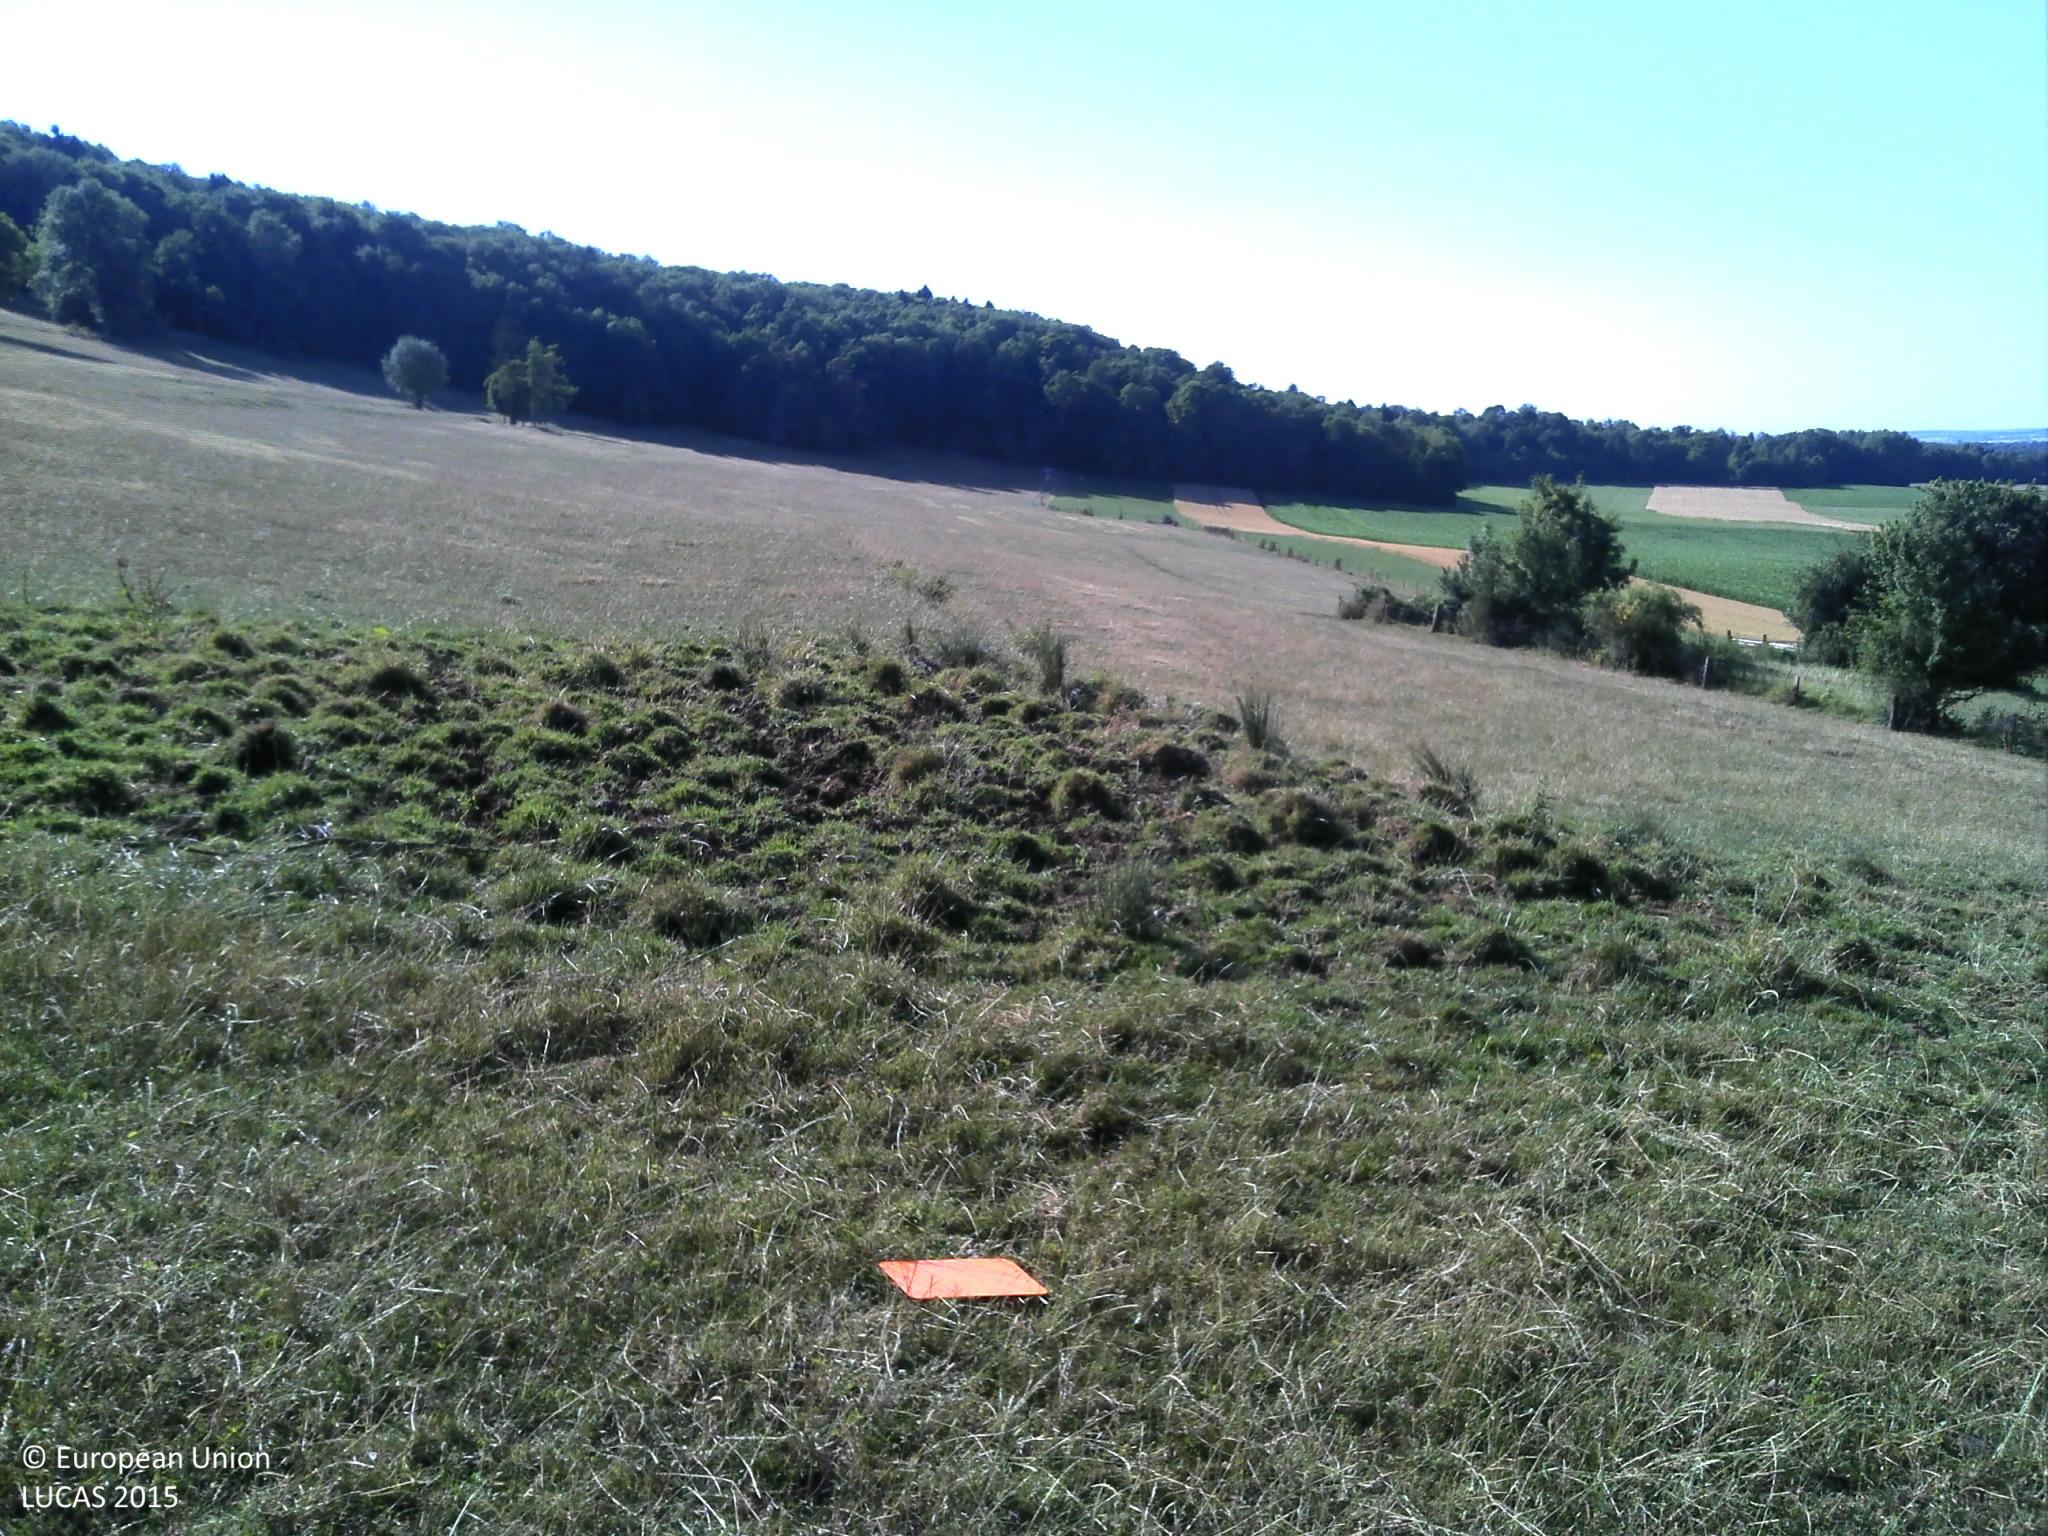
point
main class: Grassland
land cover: Grassland without tree/shrub cover
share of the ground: > 75 %
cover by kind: herbaceous plants 100 %
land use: Agriculture (excluding fallow land and kitchen gardens)
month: July
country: FR
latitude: 49.6846
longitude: 4.7437
